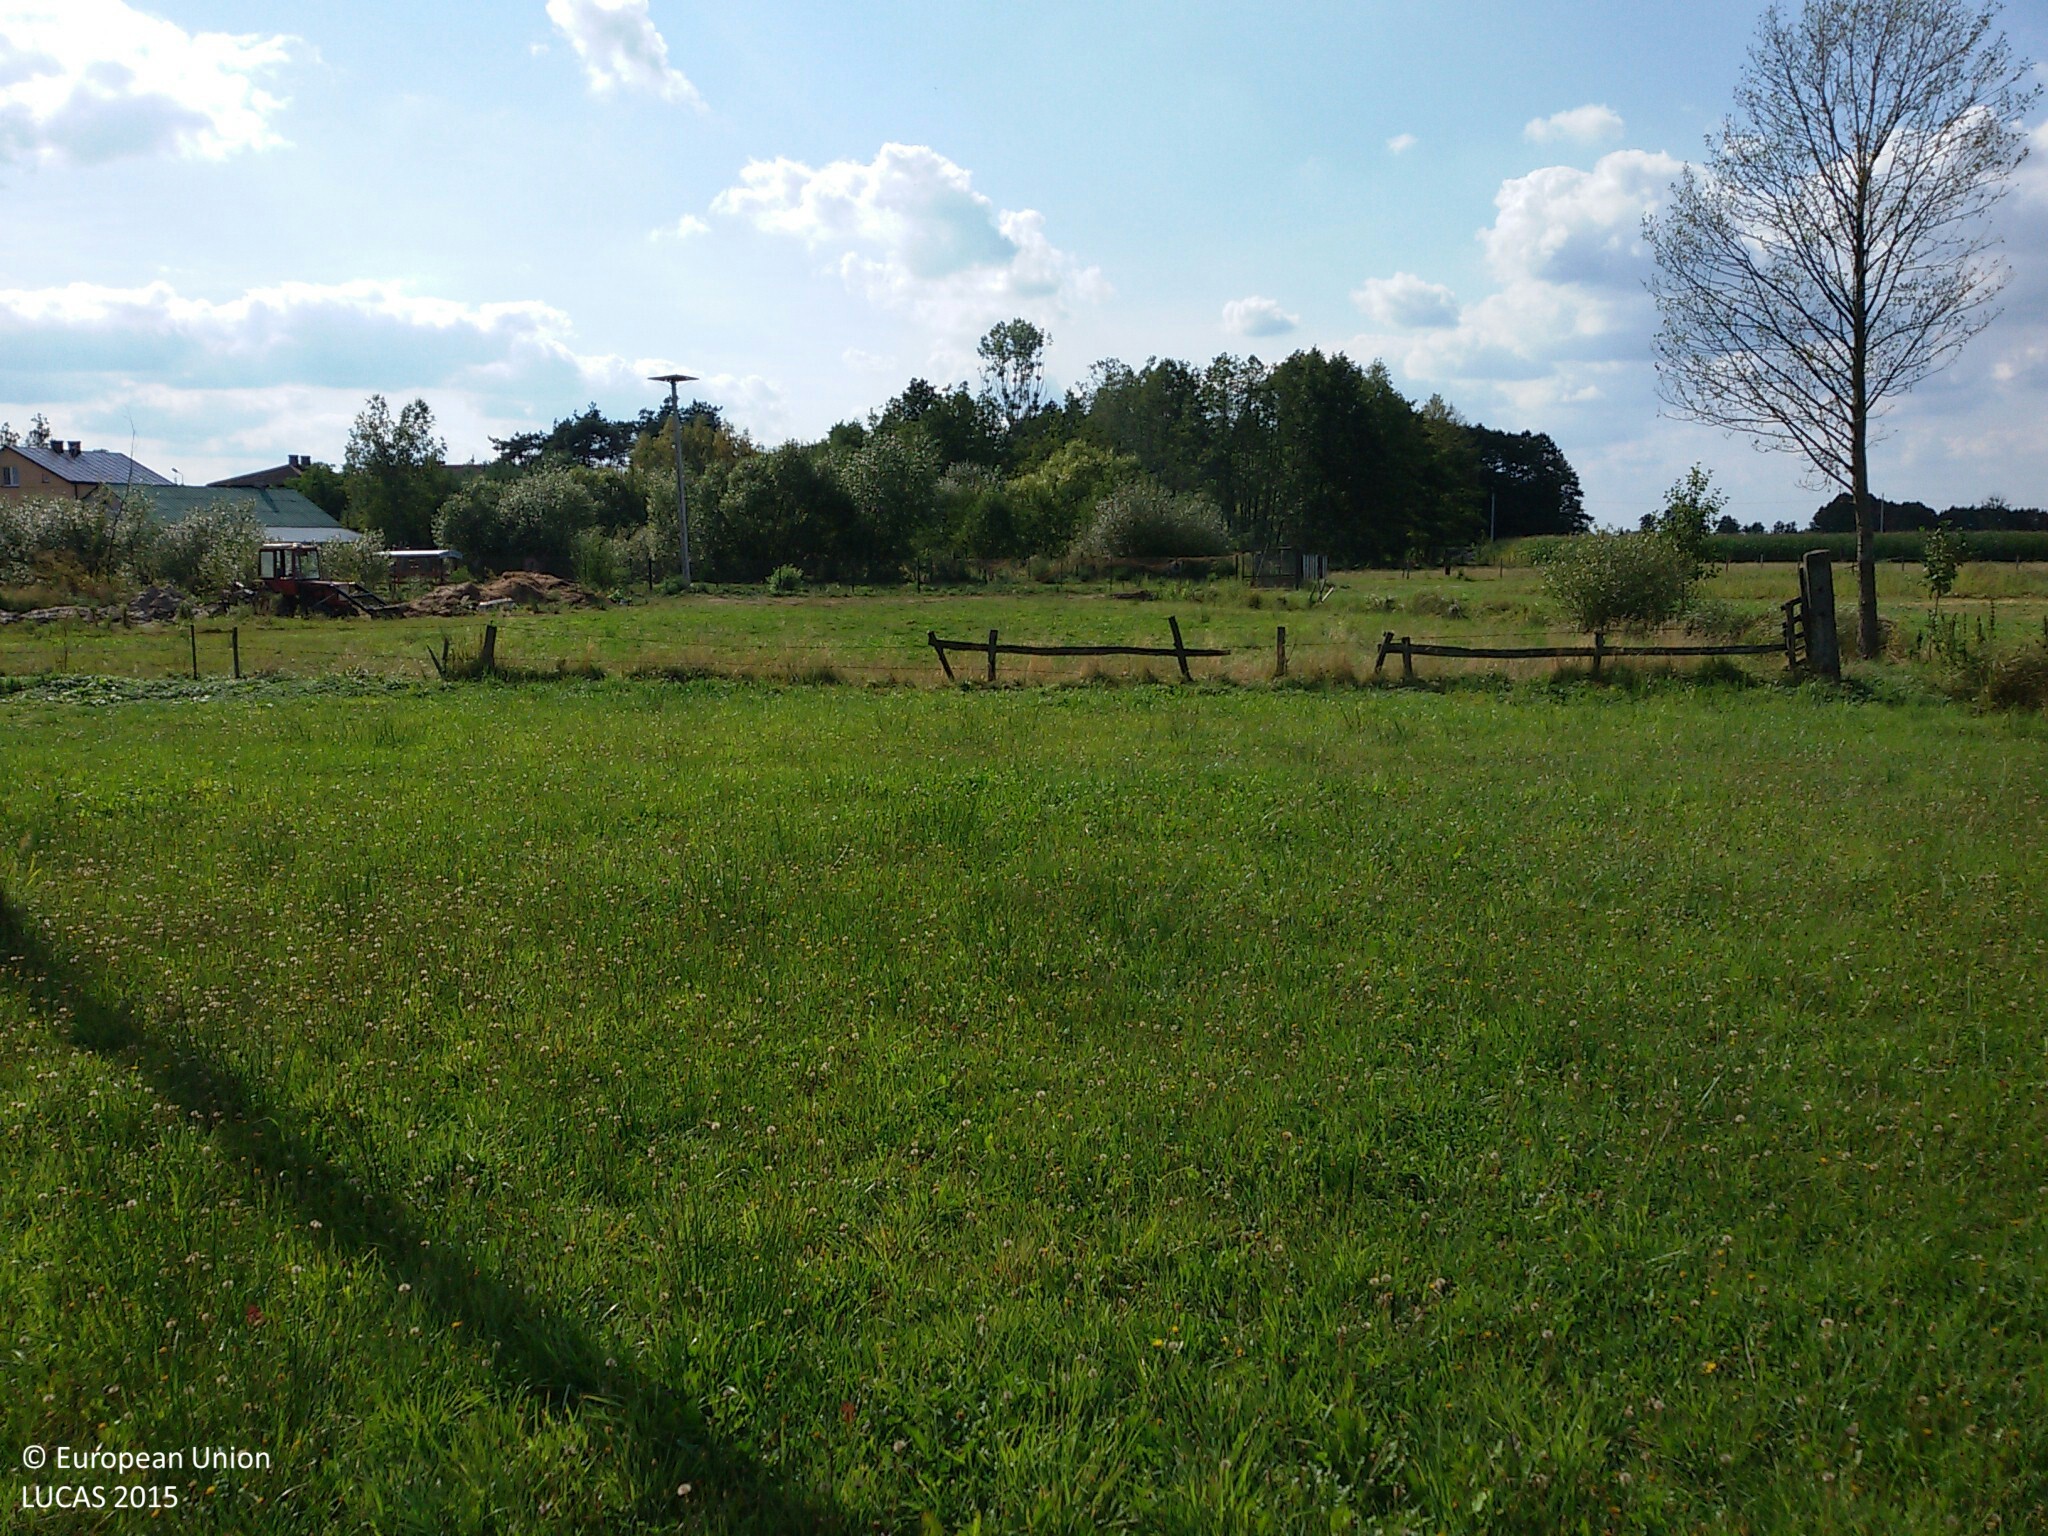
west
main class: Grassland
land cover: Grassland without tree/shrub cover
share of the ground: > 75 %
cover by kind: herbaceous plants 100 %
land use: Agriculture (excluding fallow land and kitchen gardens)
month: August
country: PL
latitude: 52.6612
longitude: 21.9595
